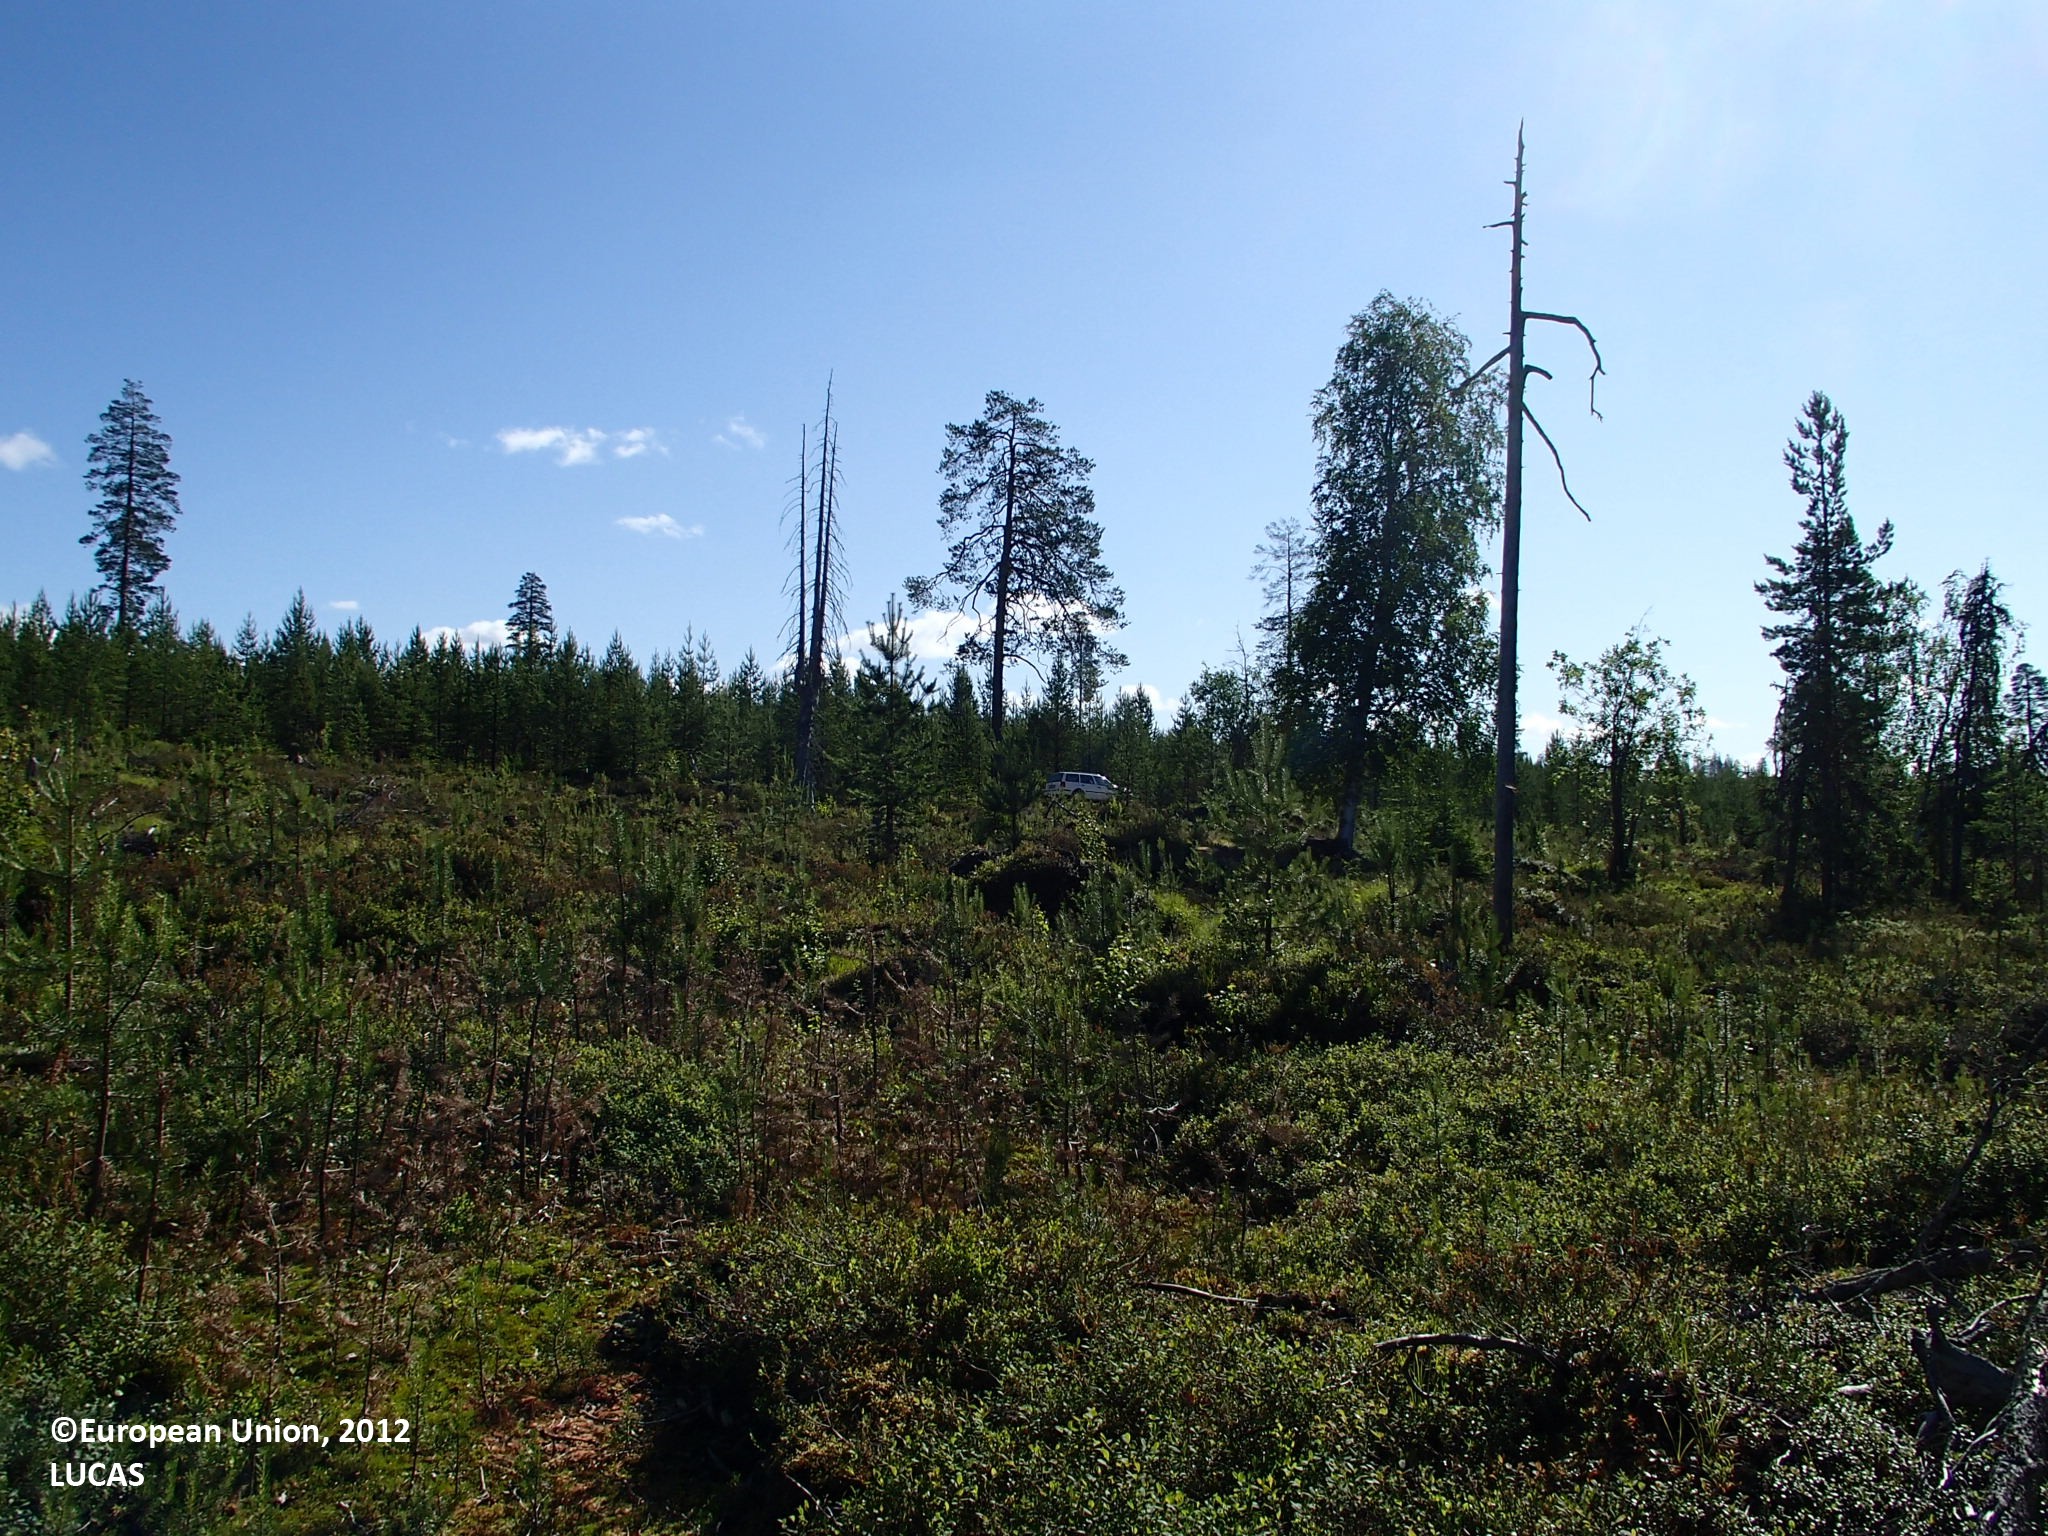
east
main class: Woodland
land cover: Pine dominated coniferous woodland
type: boreal forest
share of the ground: 25 - 50 %
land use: Forestry
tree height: < 5 m
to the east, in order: Pine dominated coniferous woodland; Ditches and canals; Paved roads, cycling and walking lanes; Ditches and canals; Pine dominated coniferous woodland
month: July
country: FI
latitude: 66.7930
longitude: 25.7335
